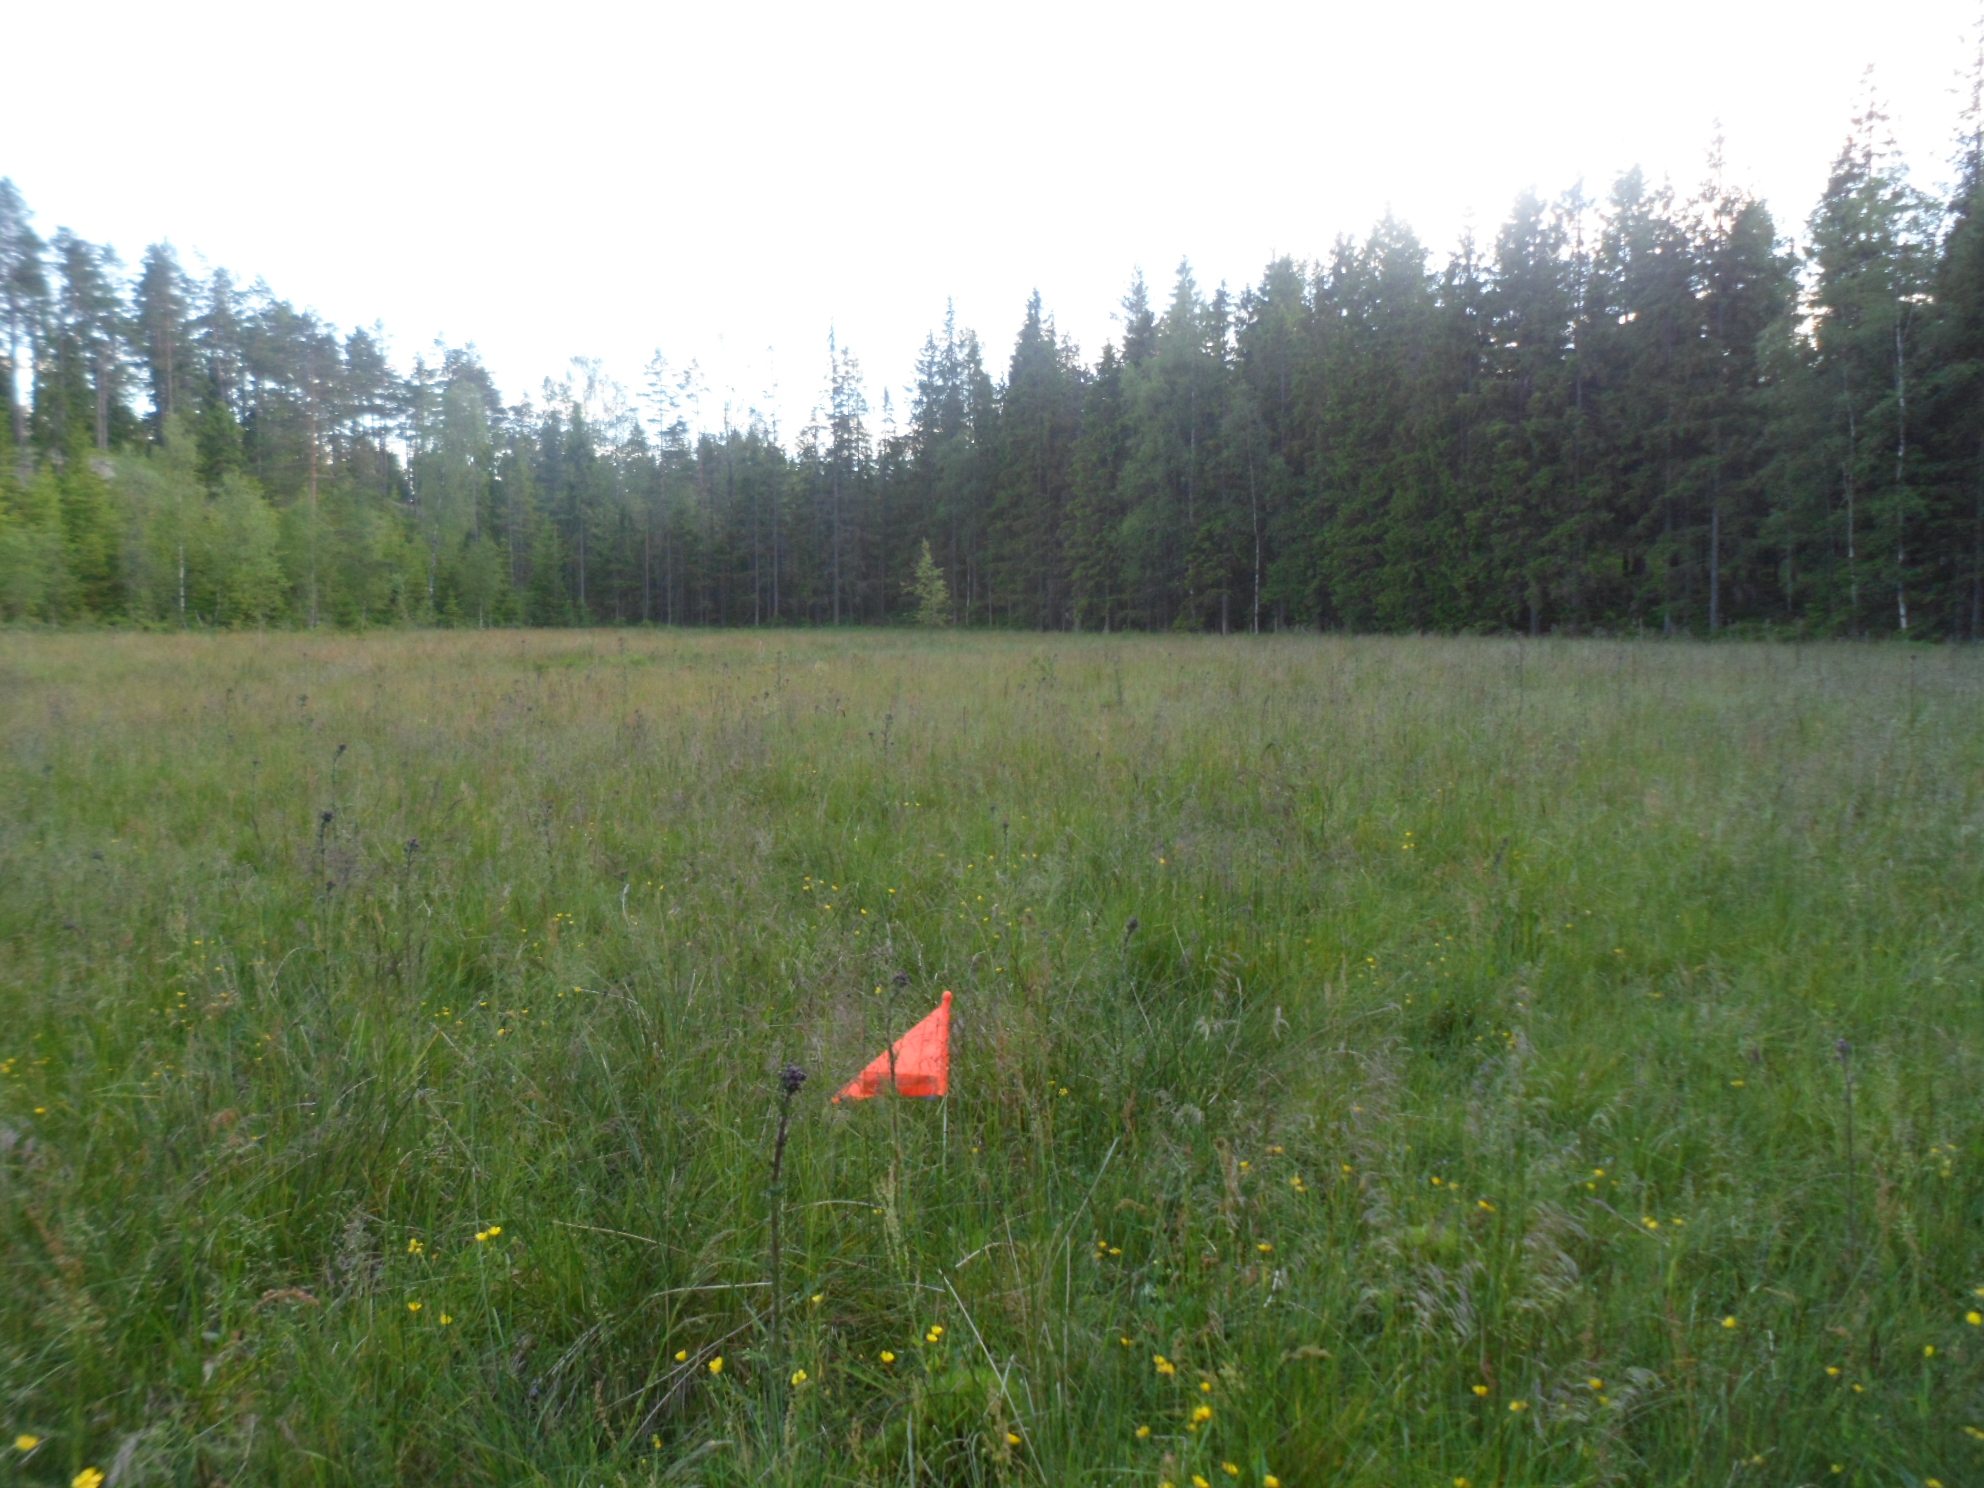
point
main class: Grassland
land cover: Grassland without tree/shrub cover
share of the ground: > 75 %
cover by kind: herbaceous plants 100 %
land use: Agriculture (excluding fallow land and kitchen gardens)
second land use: Amenities, museums, leisure
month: July
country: SE
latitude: 57.5713
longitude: 14.3928
